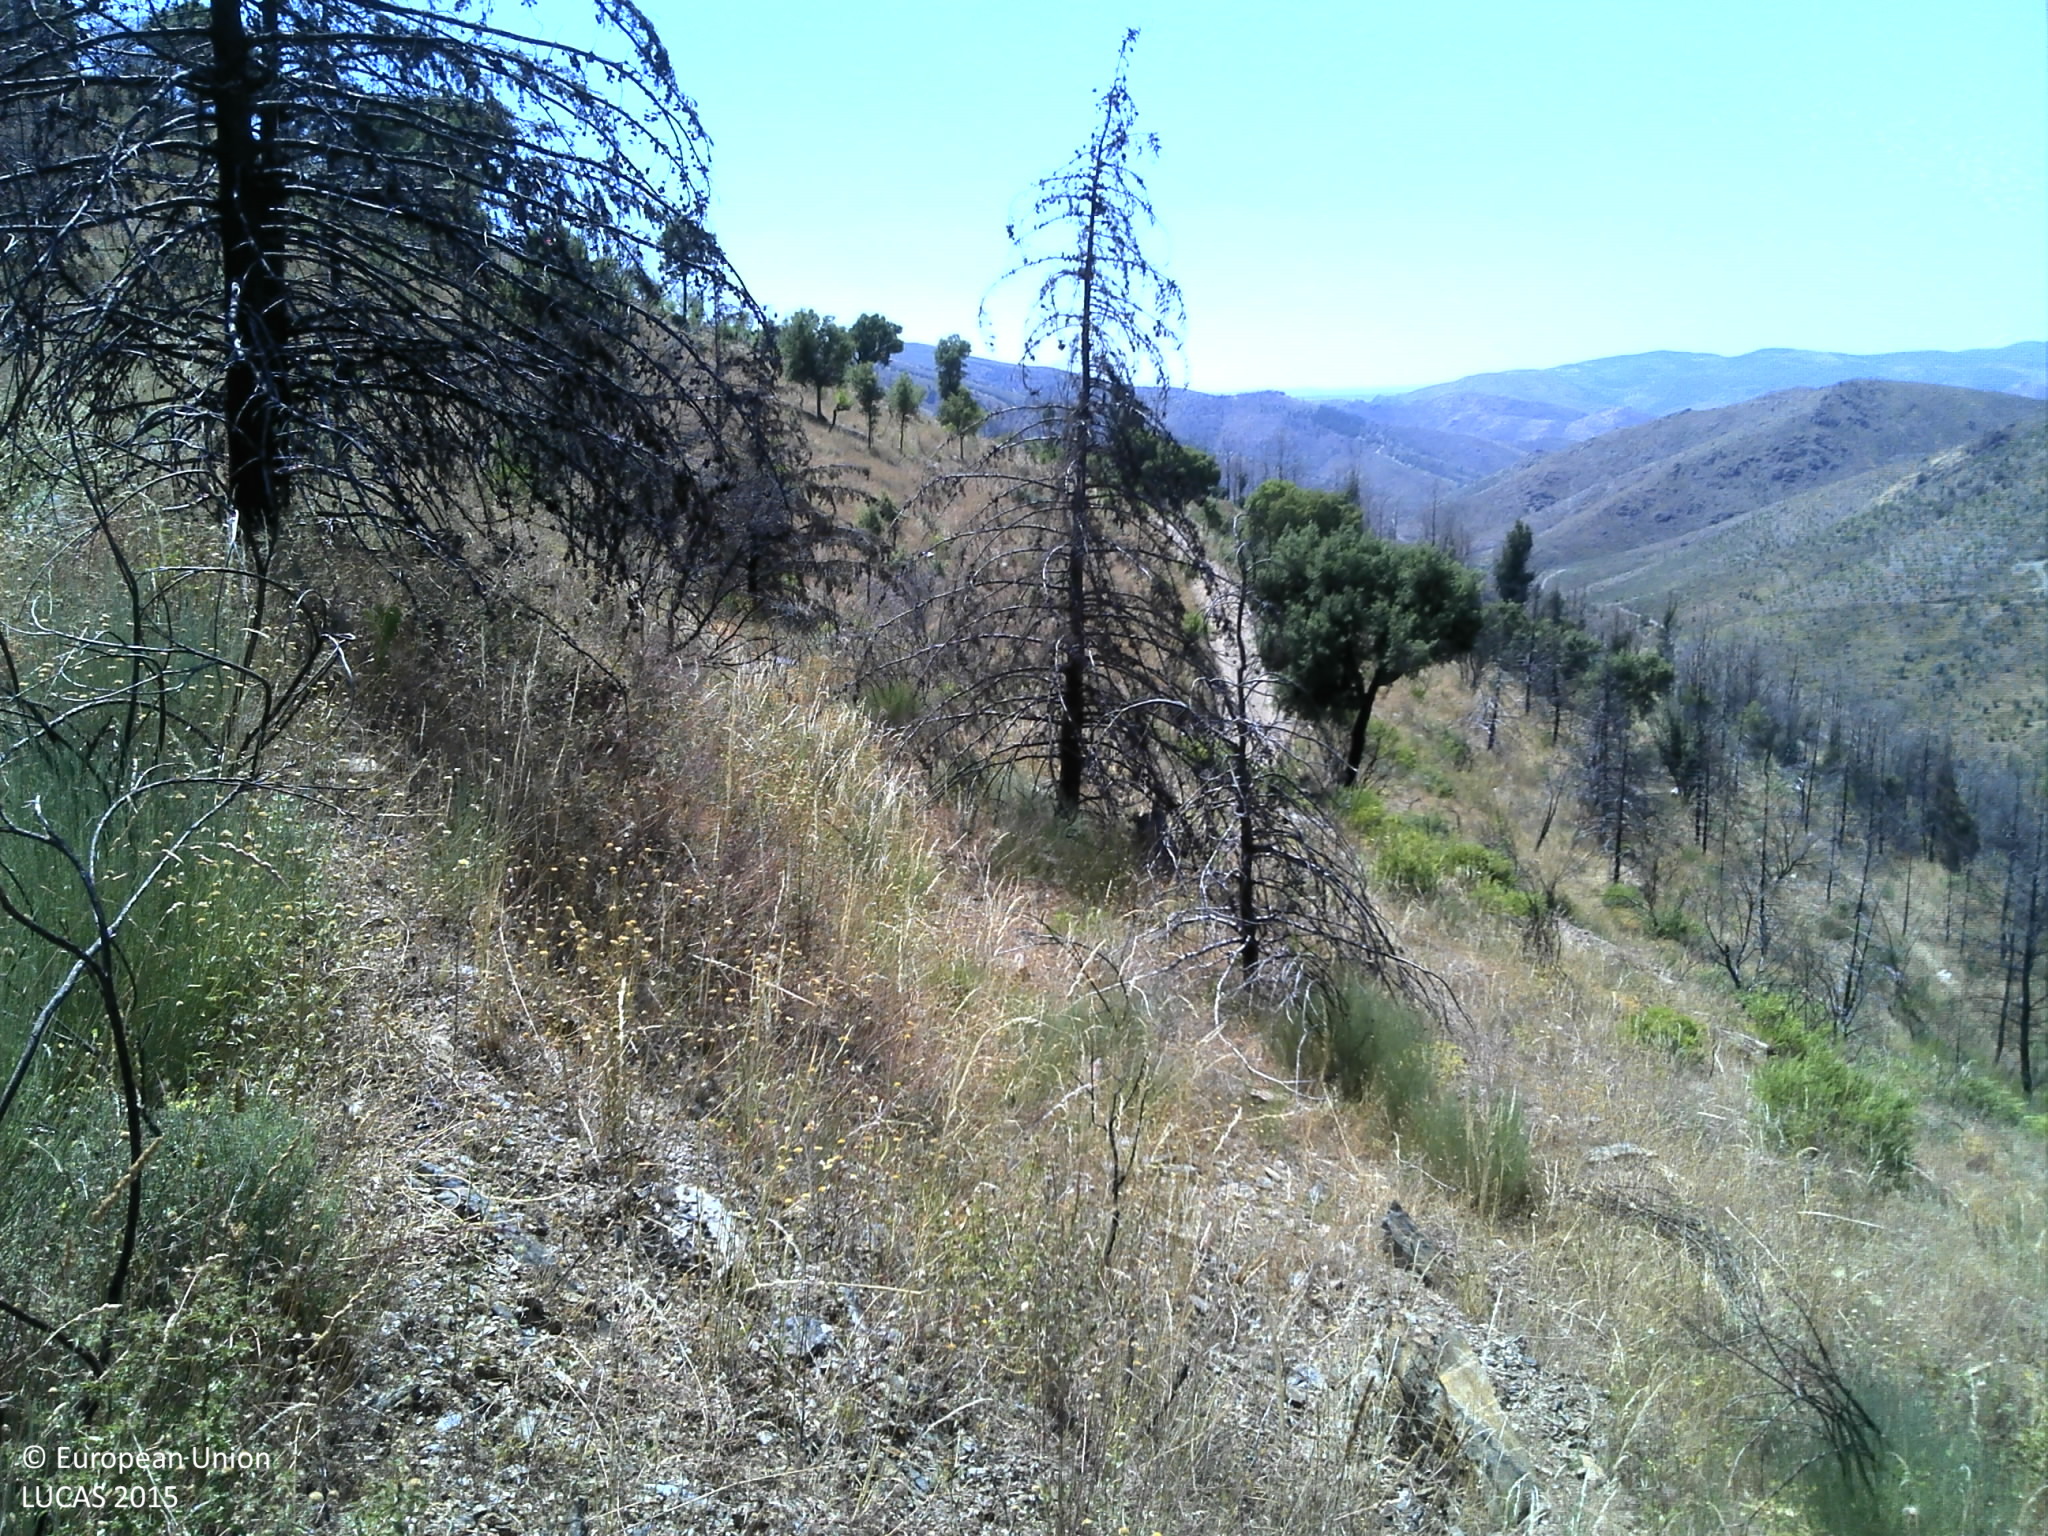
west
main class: Shrubland
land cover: Shrubland without tree cover
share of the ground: 25 - 50 %
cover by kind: herbaceous plants 50 %, unconsolidated bare surface 20 %, shrubs 10 %
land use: Abandoned areas
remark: Burnt area
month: June
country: PT
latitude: 41.2353
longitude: -6.8216
